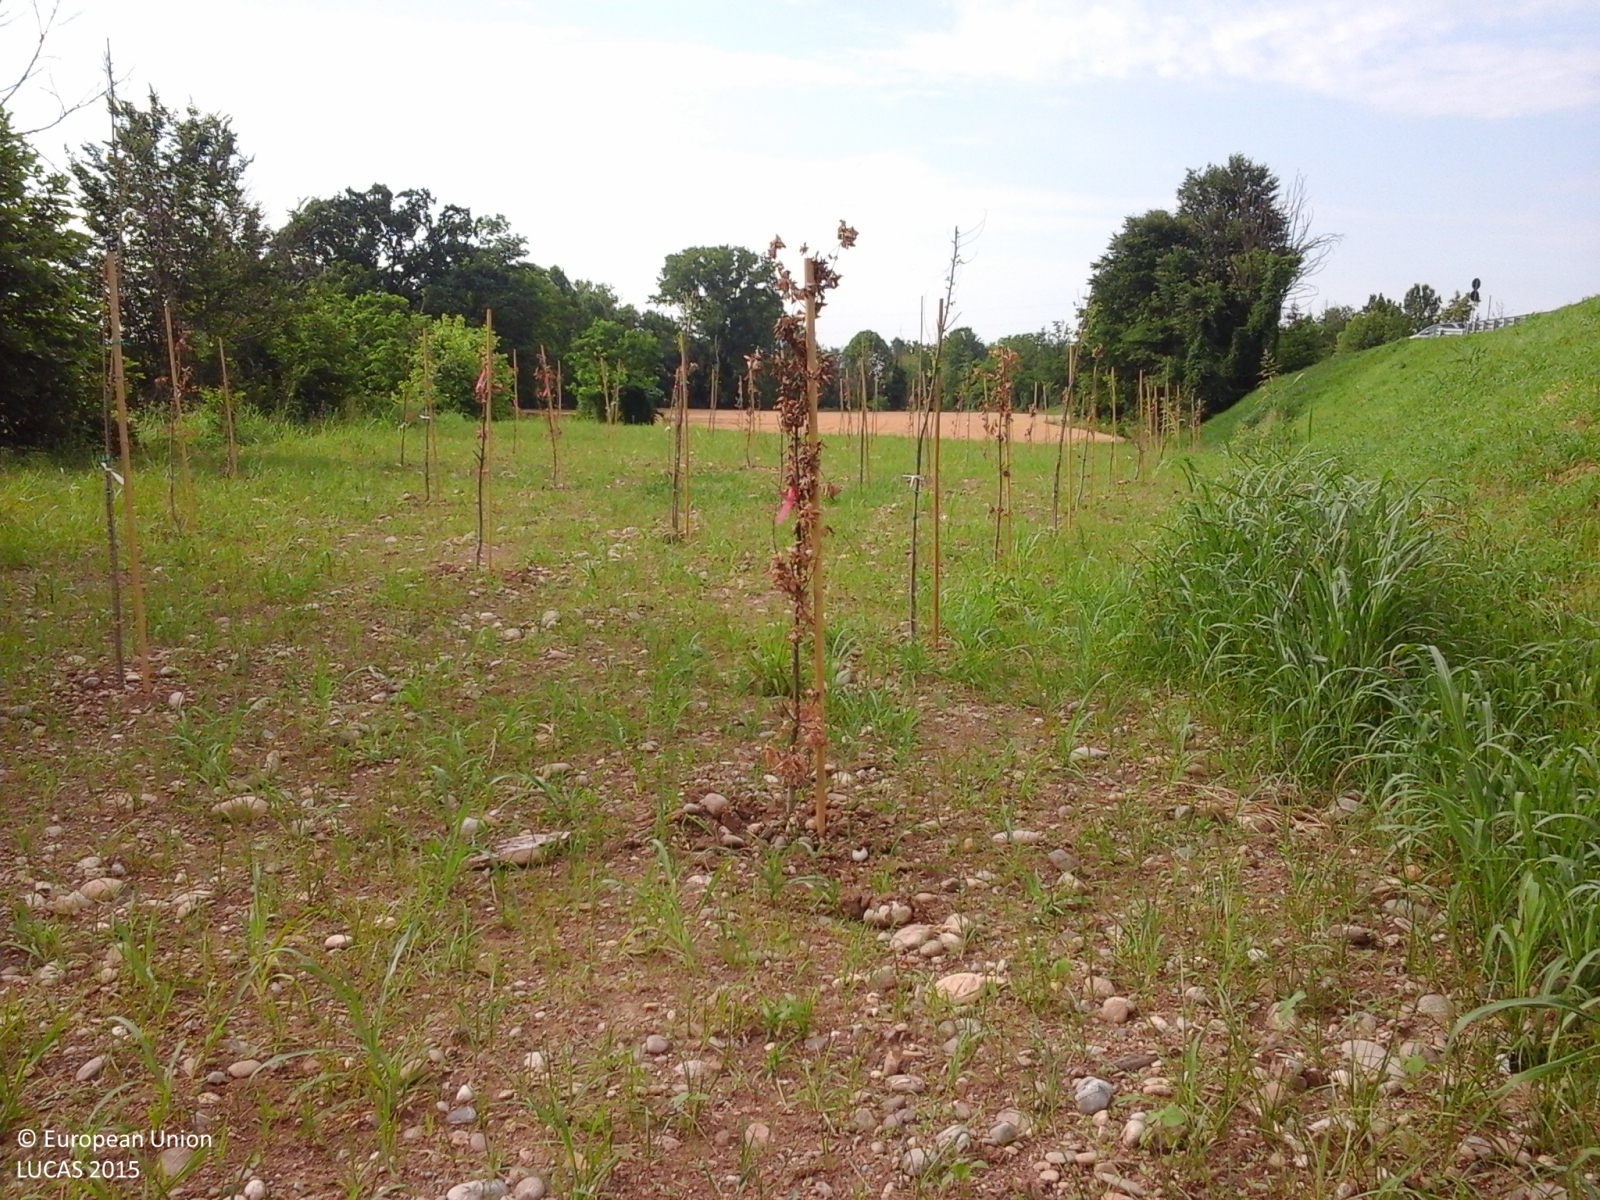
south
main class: Grassland
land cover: Grassland with sparse tree/shrub cover
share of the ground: > 75 %
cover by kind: herbaceous plants 95 %, broadleaved forest trees 5 %
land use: Road transport
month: June
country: IT
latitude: 45.5043
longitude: 9.8595
